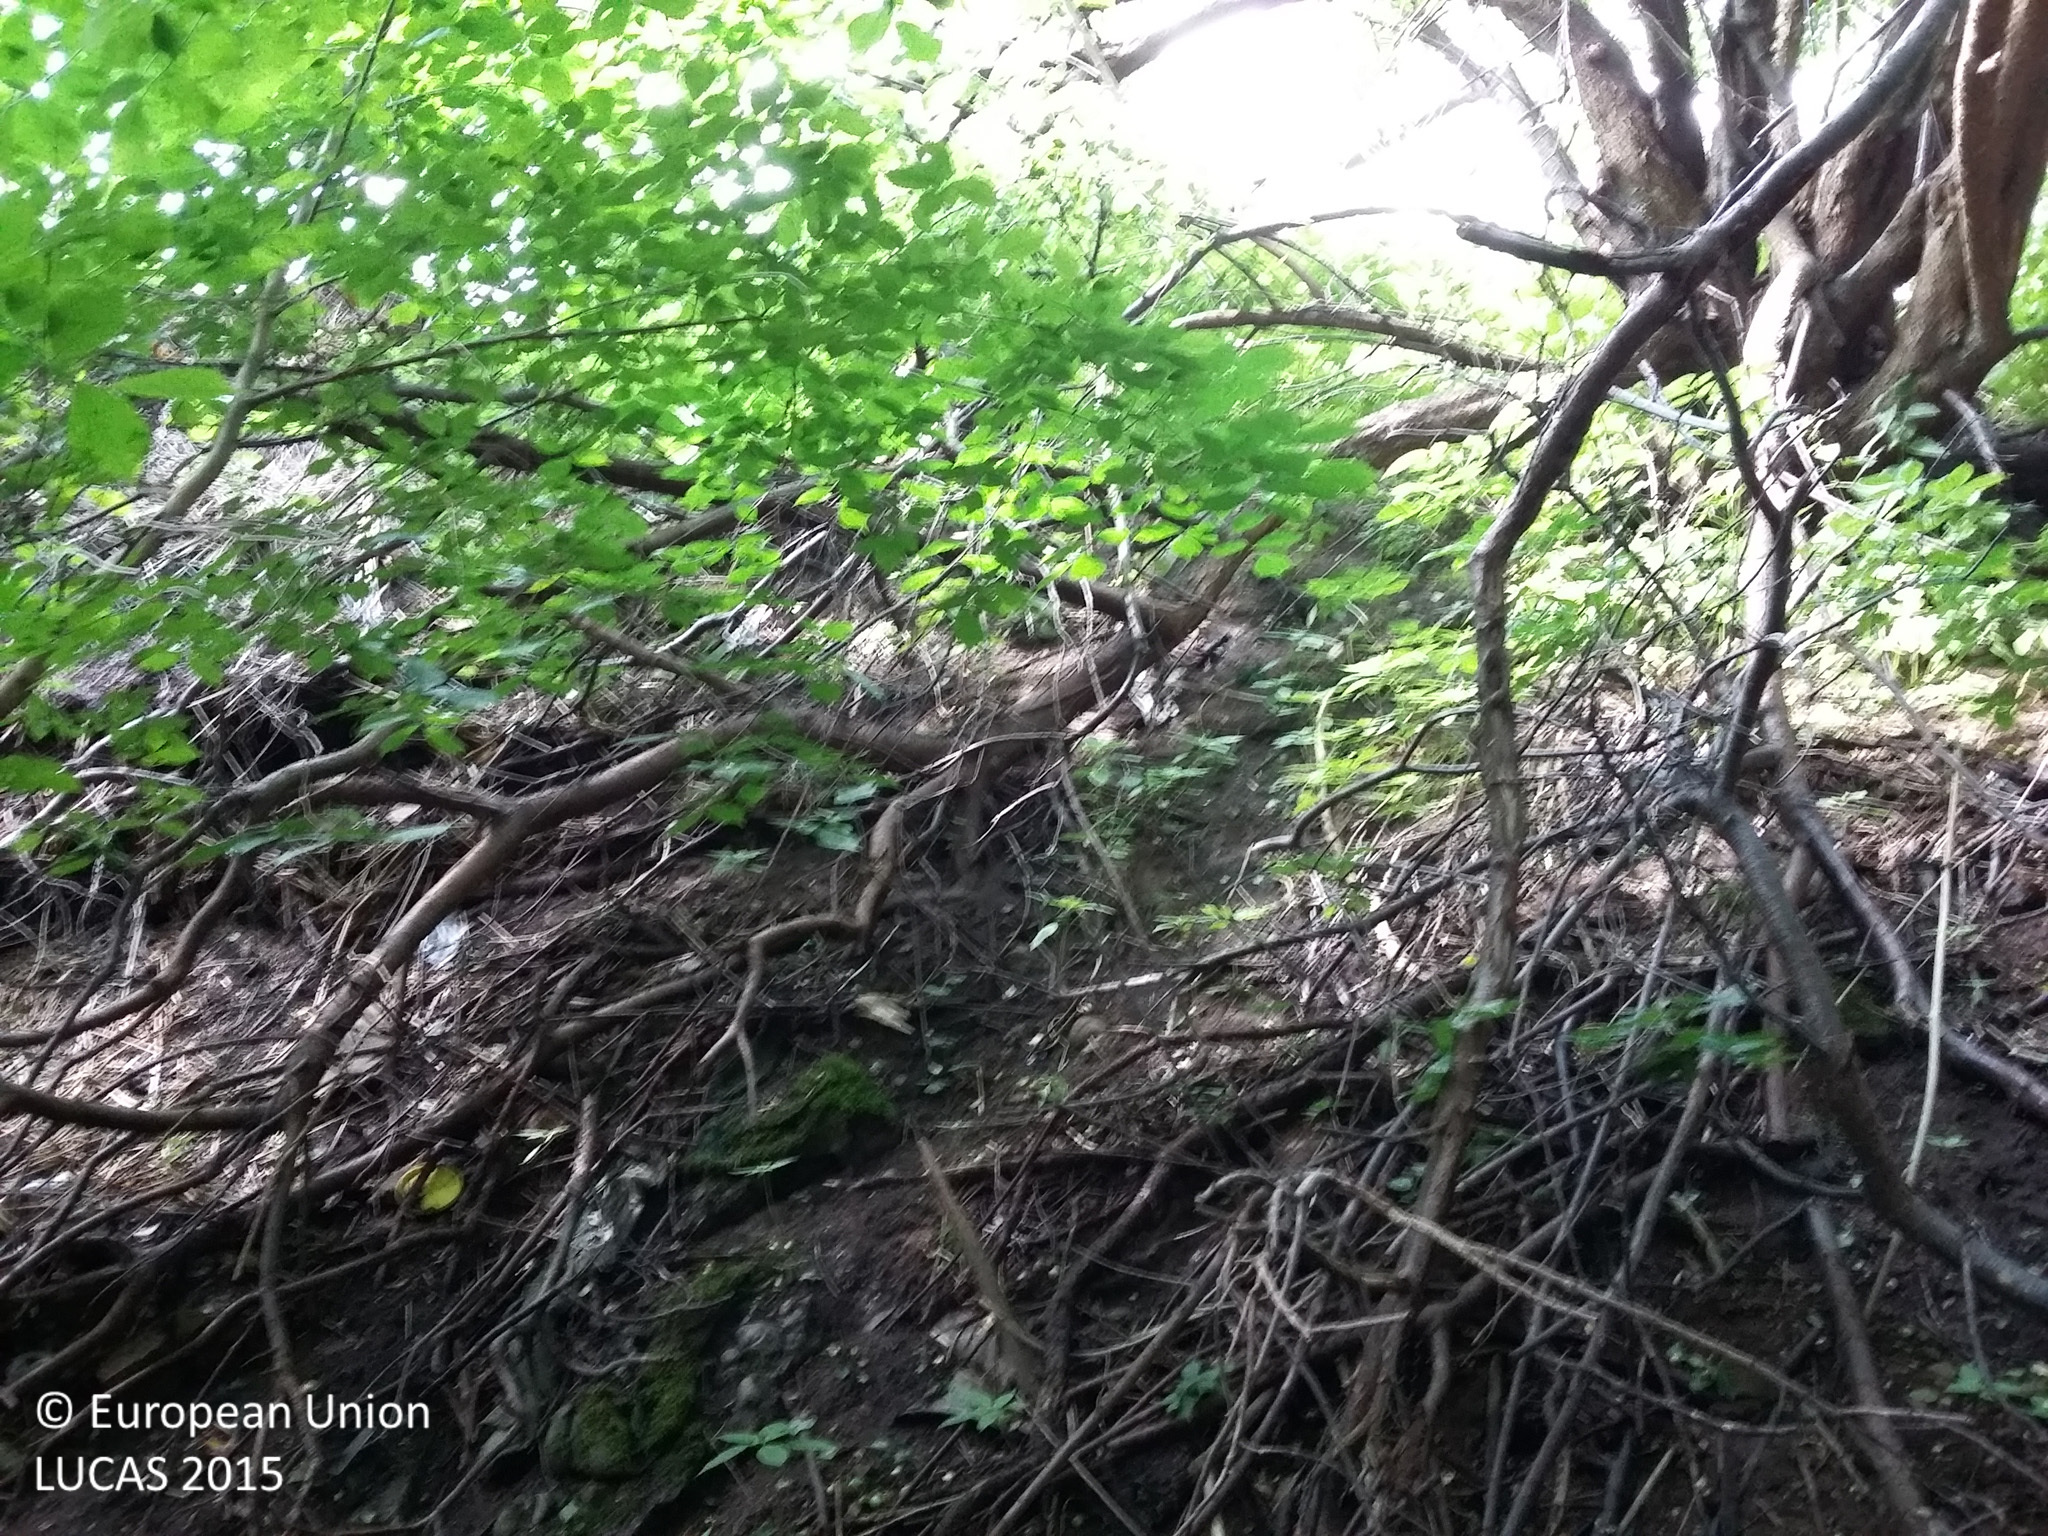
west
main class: Woodland
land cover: Broadleaved woodland
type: beech forest
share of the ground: > 75 %
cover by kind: broadleaved forest trees 80 %, herbaceous plants 15 %, shrubs 5 %
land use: Semi-natural and natural areas not in use
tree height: > 5 m
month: July
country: DK
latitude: 55.4954
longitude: 11.5341
